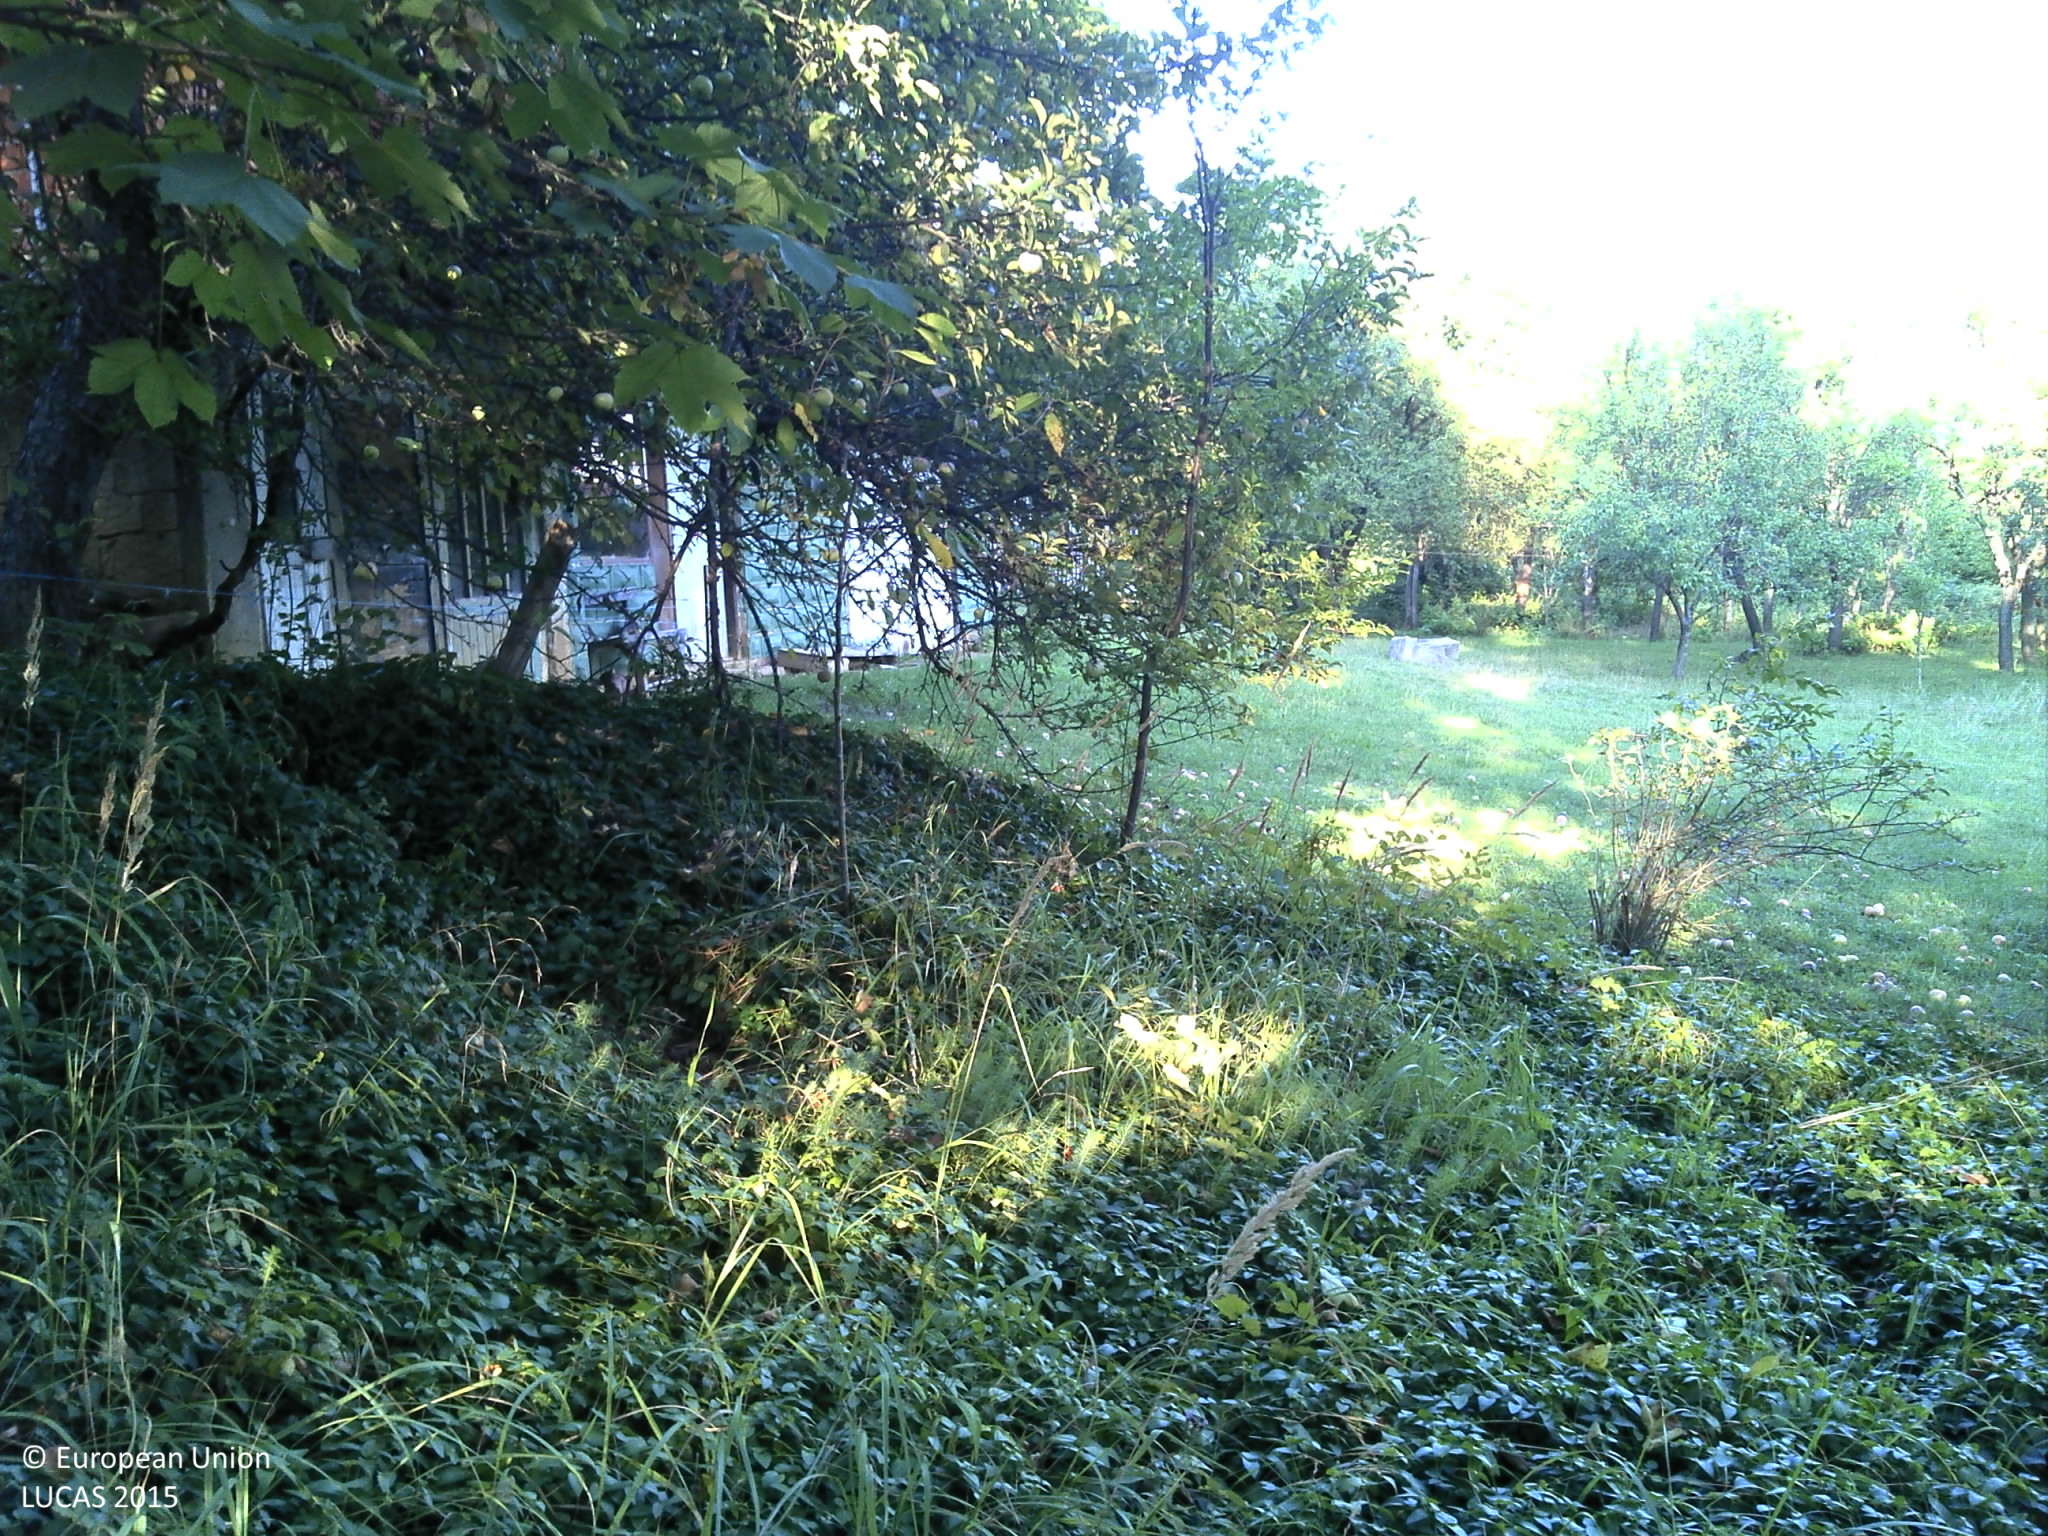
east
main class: Woodland
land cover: Broadleaved woodland
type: beech forest
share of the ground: > 75 %
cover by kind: broadleaved forest trees 100 %
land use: Forestry
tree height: > 5 m
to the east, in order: Broadleaved woodland; Artificial constructions in urban areas; Other fruit trees and berries; Spontaneously vegetated surfaces; Broadleaved woodland
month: August
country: HR
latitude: 45.3571
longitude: 15.9068
